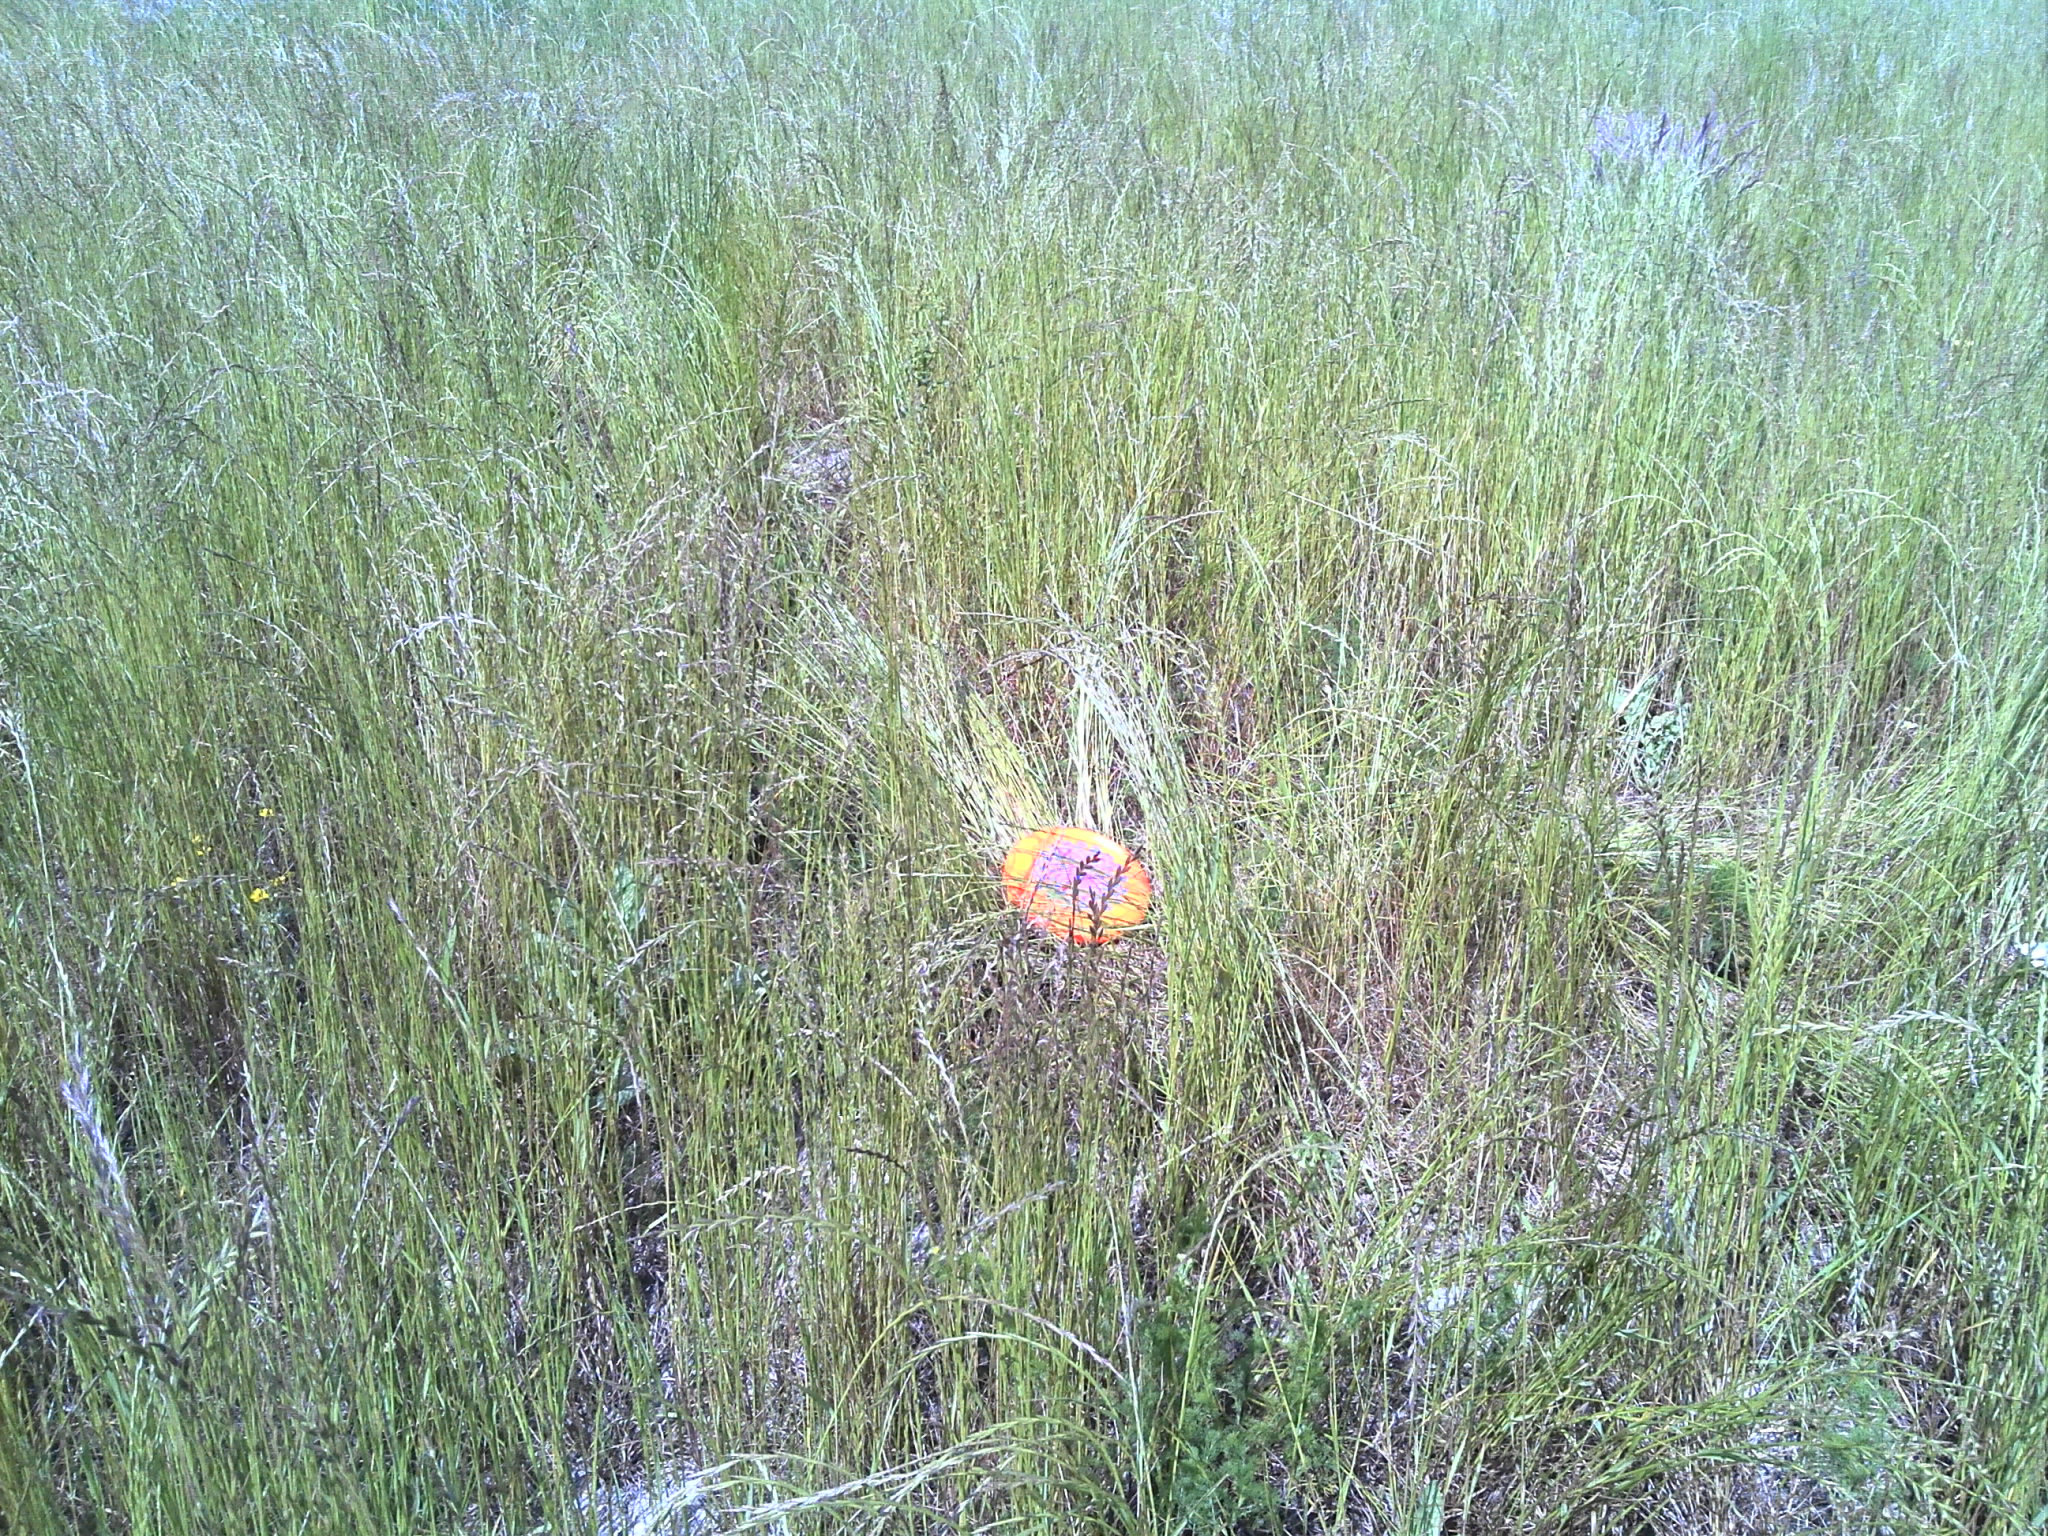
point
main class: Cropland
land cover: Temporary grasslands
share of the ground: > 75 %
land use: Agriculture (excluding fallow land and kitchen gardens)
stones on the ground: < 10 %
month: May
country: FR
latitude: 46.6709
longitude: 1.5848
